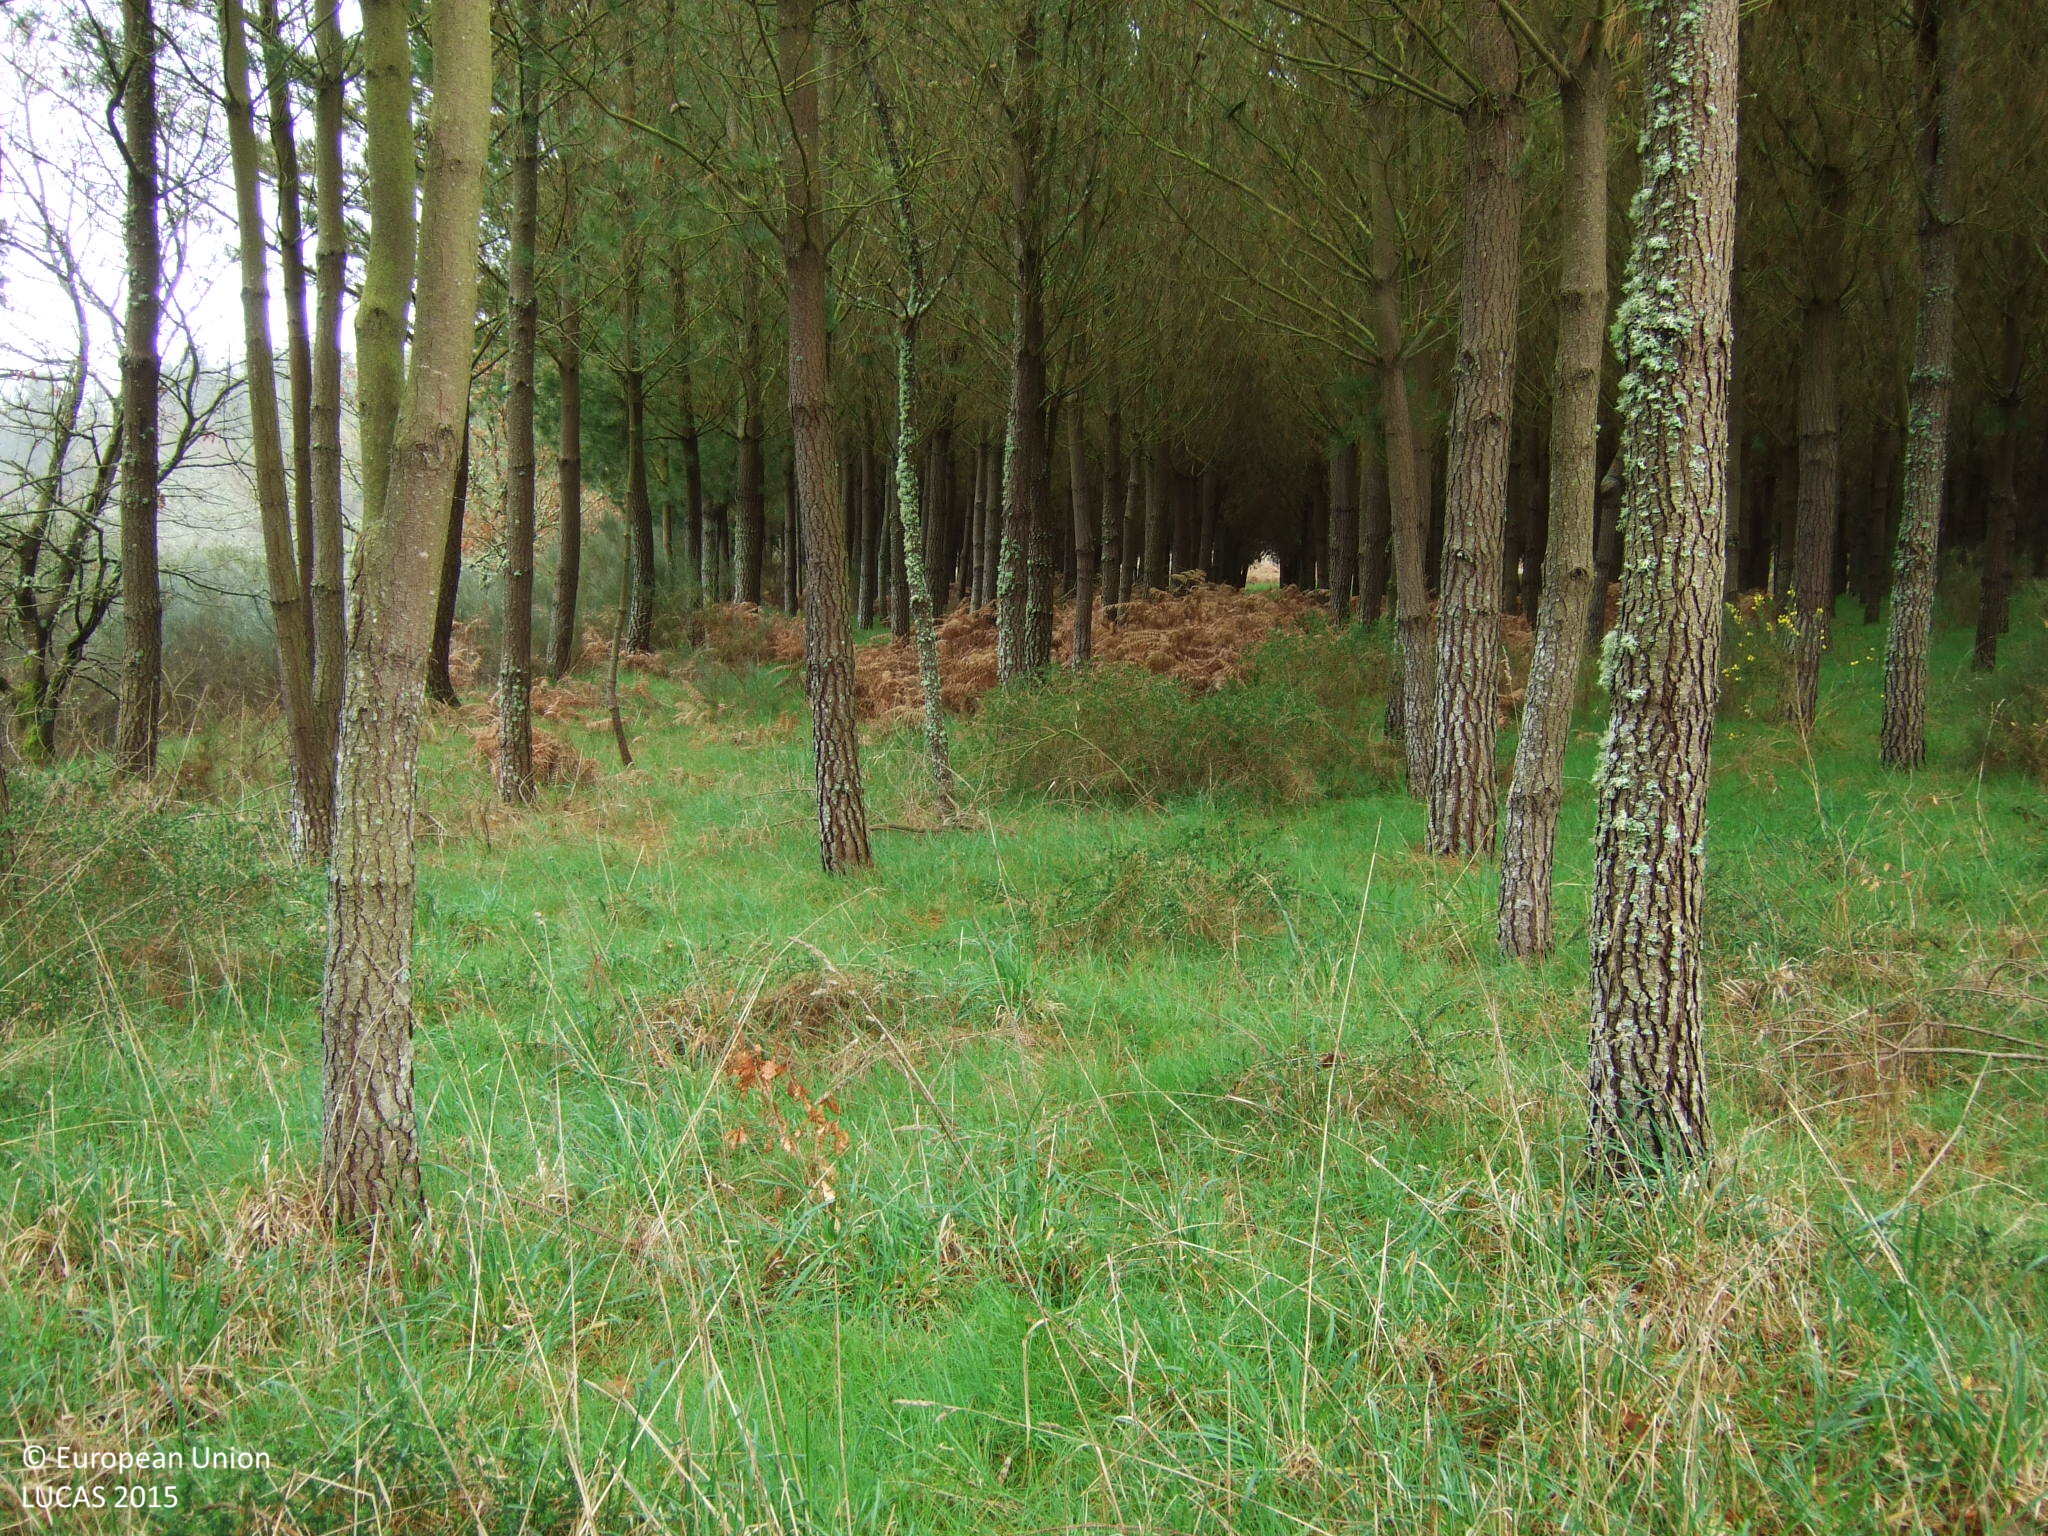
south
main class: Woodland
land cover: Pine dominated coniferous woodland
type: exotic forest
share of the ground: > 75 %
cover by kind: coniferous forest trees 90 %, shrubs 10 %
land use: Forestry
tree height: > 5 m
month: March
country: ES
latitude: 42.8014
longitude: -7.8745
